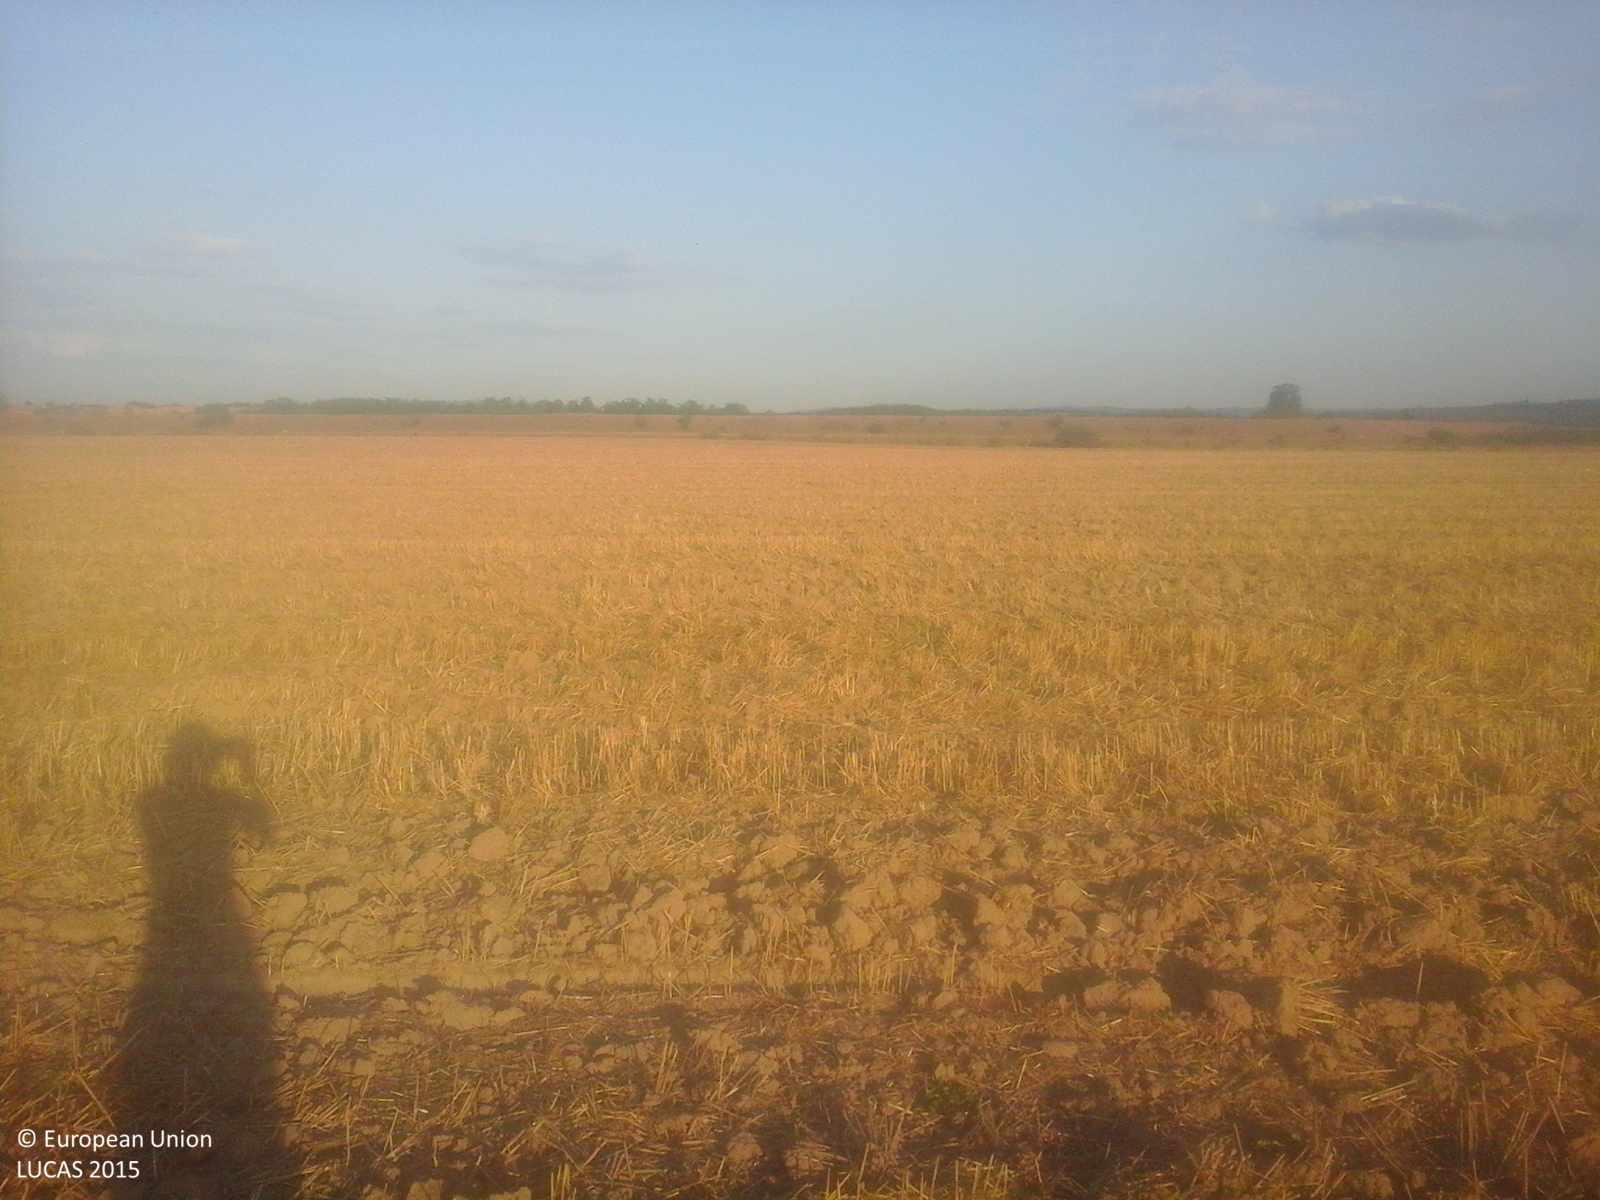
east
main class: Cropland
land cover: Common wheat
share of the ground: 10 - 25 %
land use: Agriculture (excluding fallow land and kitchen gardens)
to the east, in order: Common wheat; Ditches and canals
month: September
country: RO
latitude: 47.6814
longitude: 22.8924
